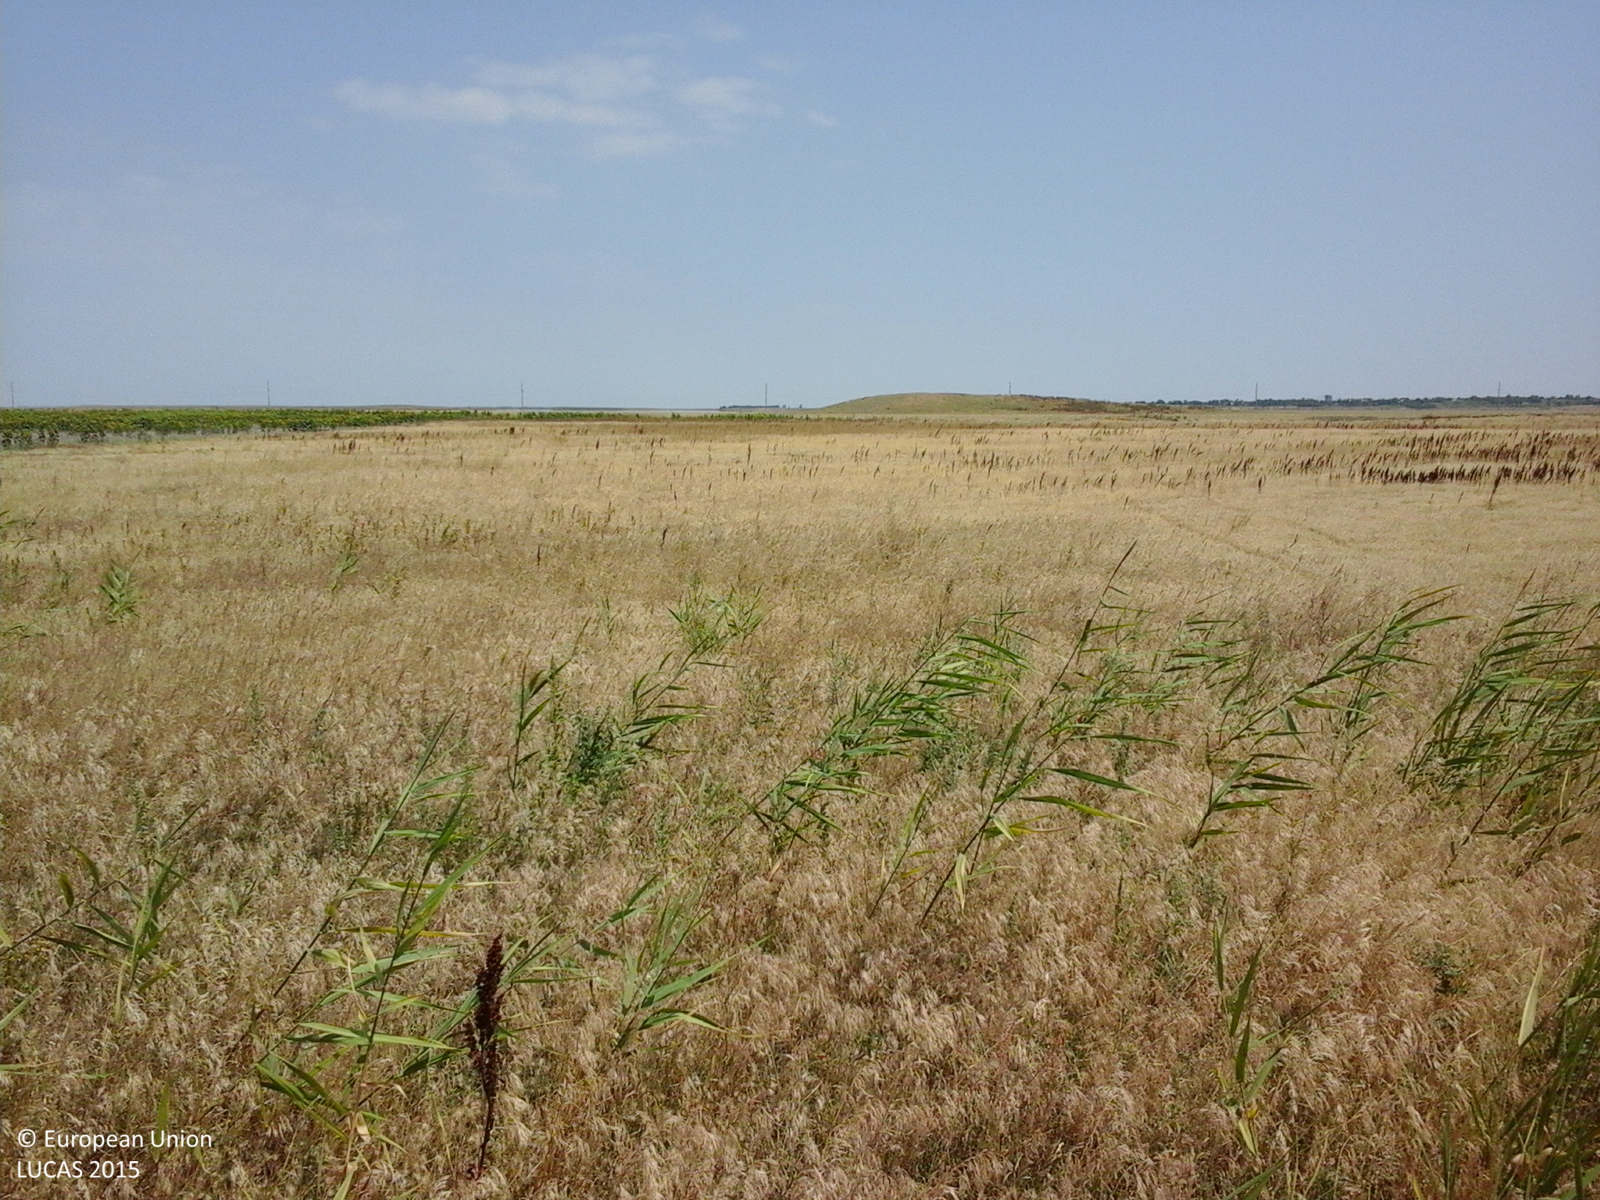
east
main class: Grassland
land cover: Spontaneously vegetated surfaces
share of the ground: > 75 %
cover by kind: herbaceous plants 100 %
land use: Fallow land
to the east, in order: Spontaneously vegetated surfaces; Grass margins; Ditches and canals; Grass margins; Tracks; Grassland without tree/shrub cover
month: July
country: RO
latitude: 44.9693
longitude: 27.2709
